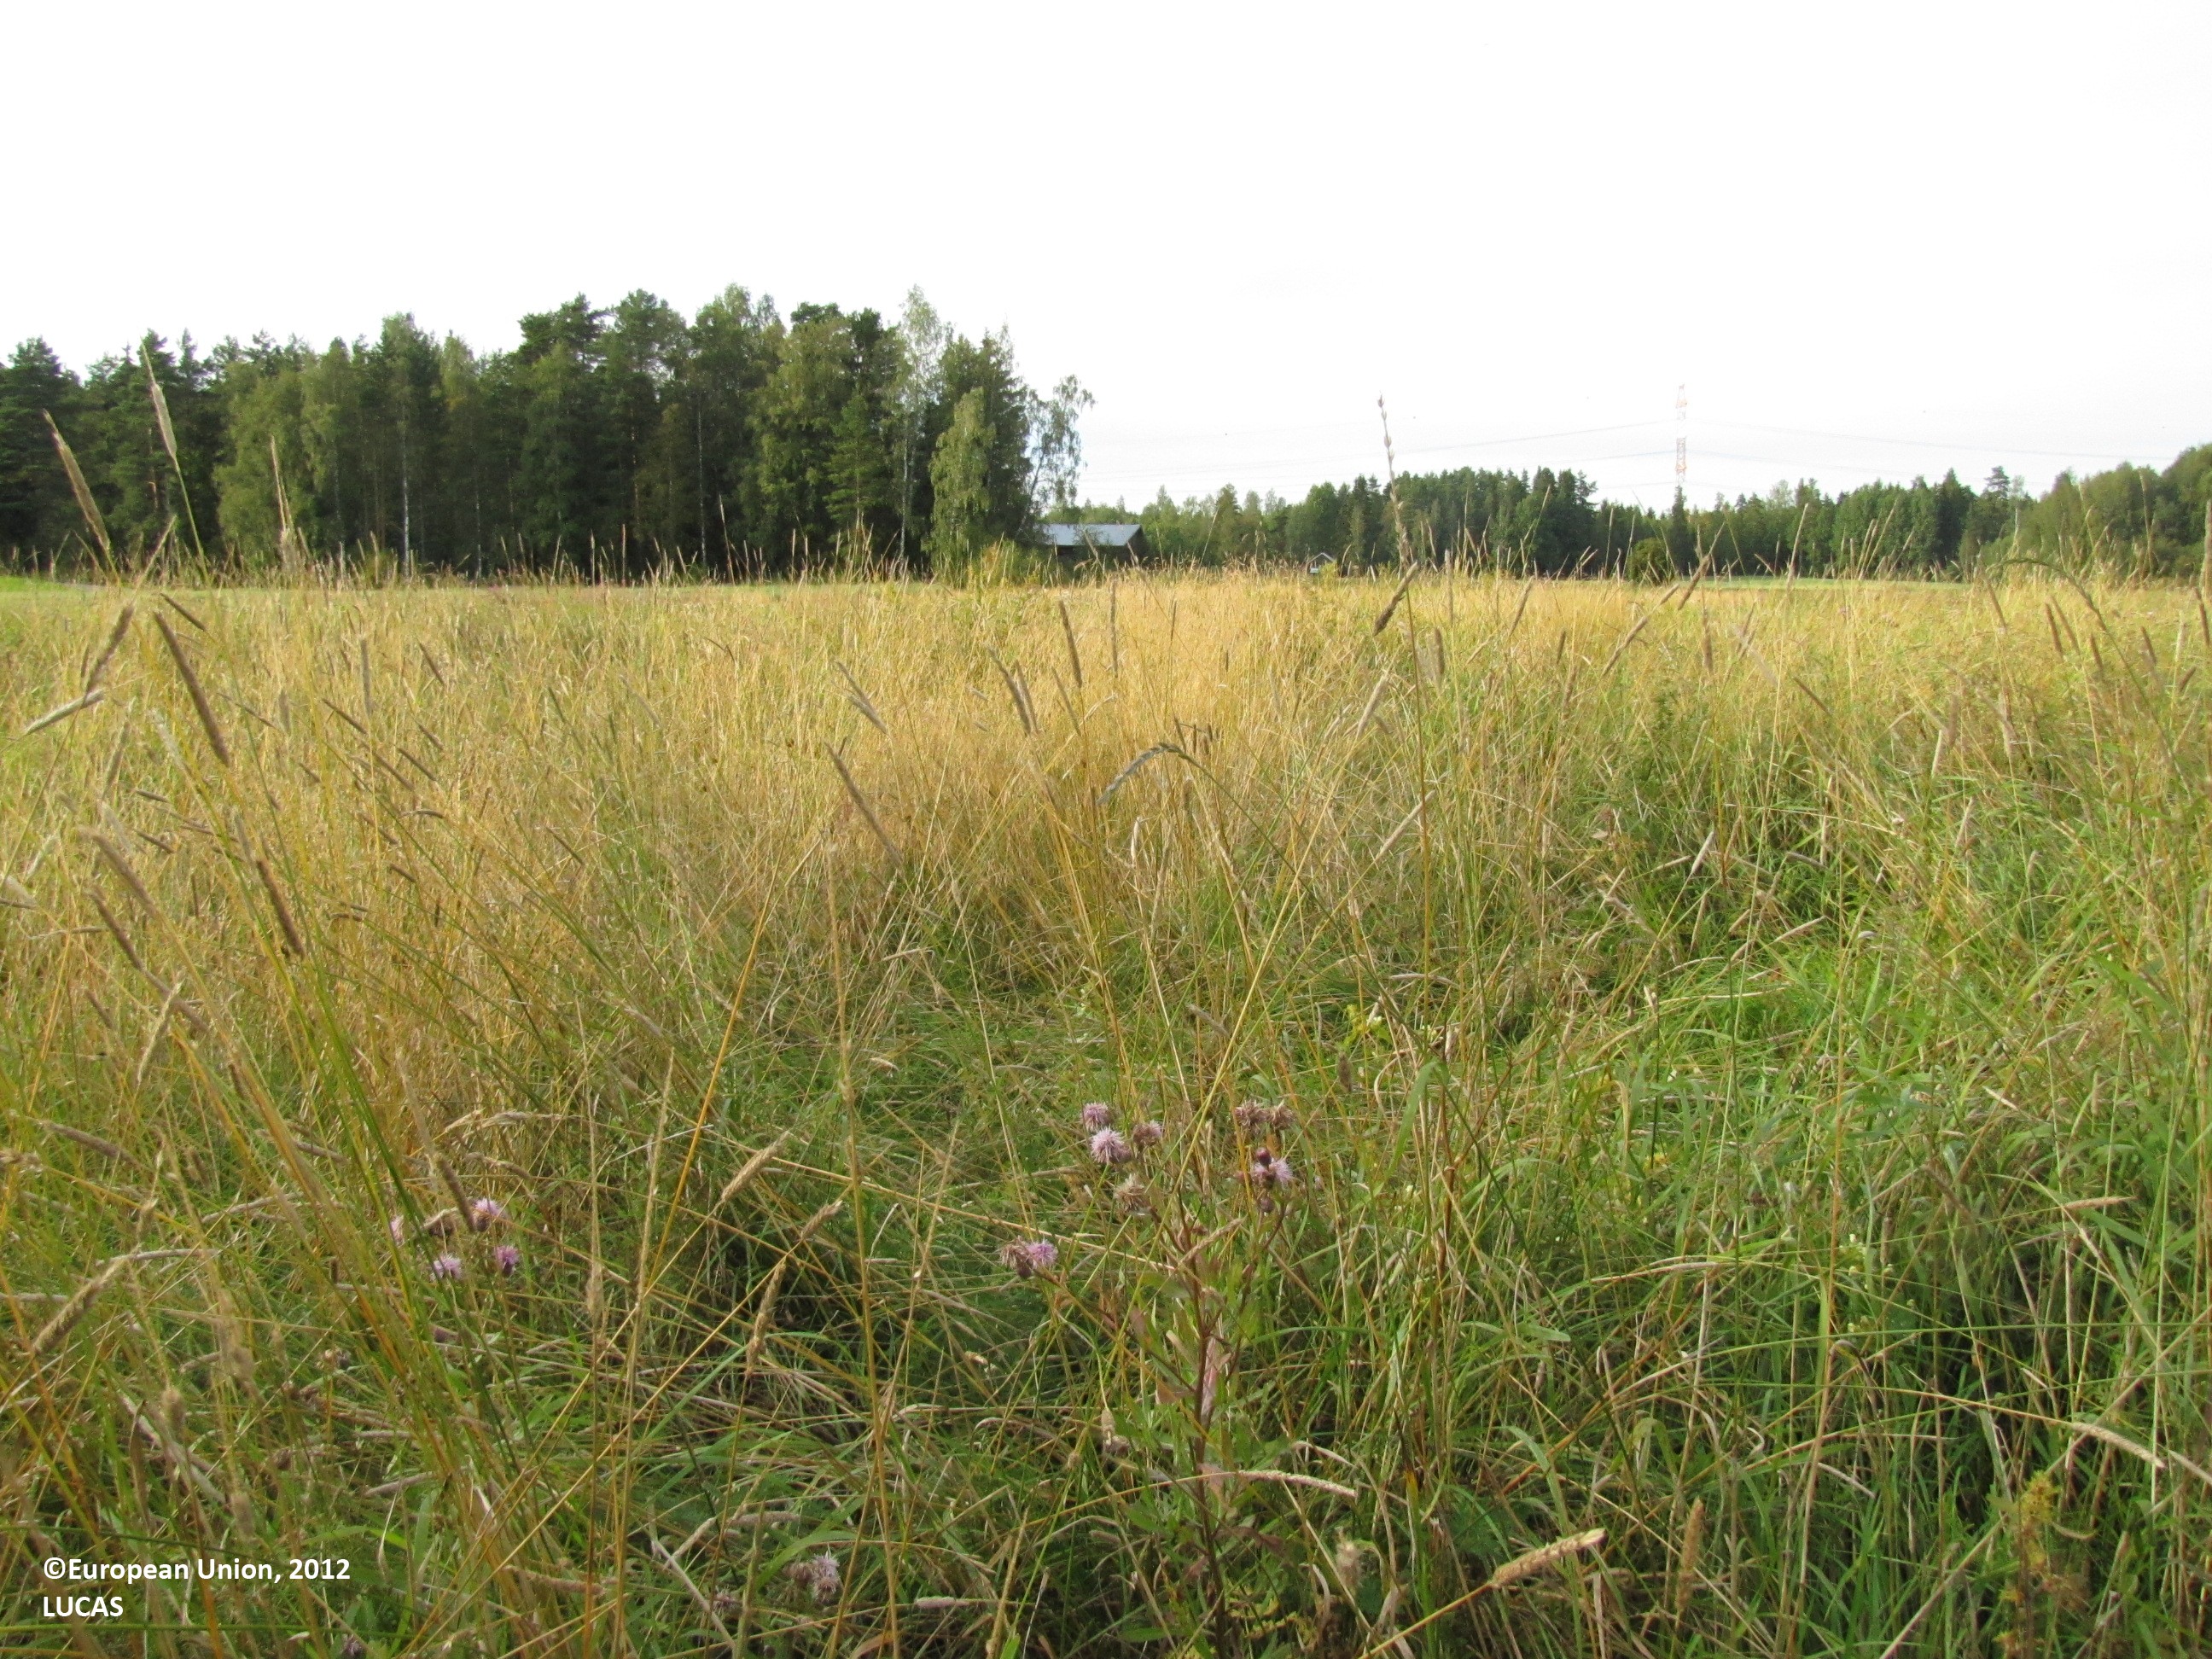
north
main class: Grassland
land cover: Grassland without tree/shrub cover
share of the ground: > 75 %
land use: Fallow land
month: August
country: FI
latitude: 61.3883
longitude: 23.5785
